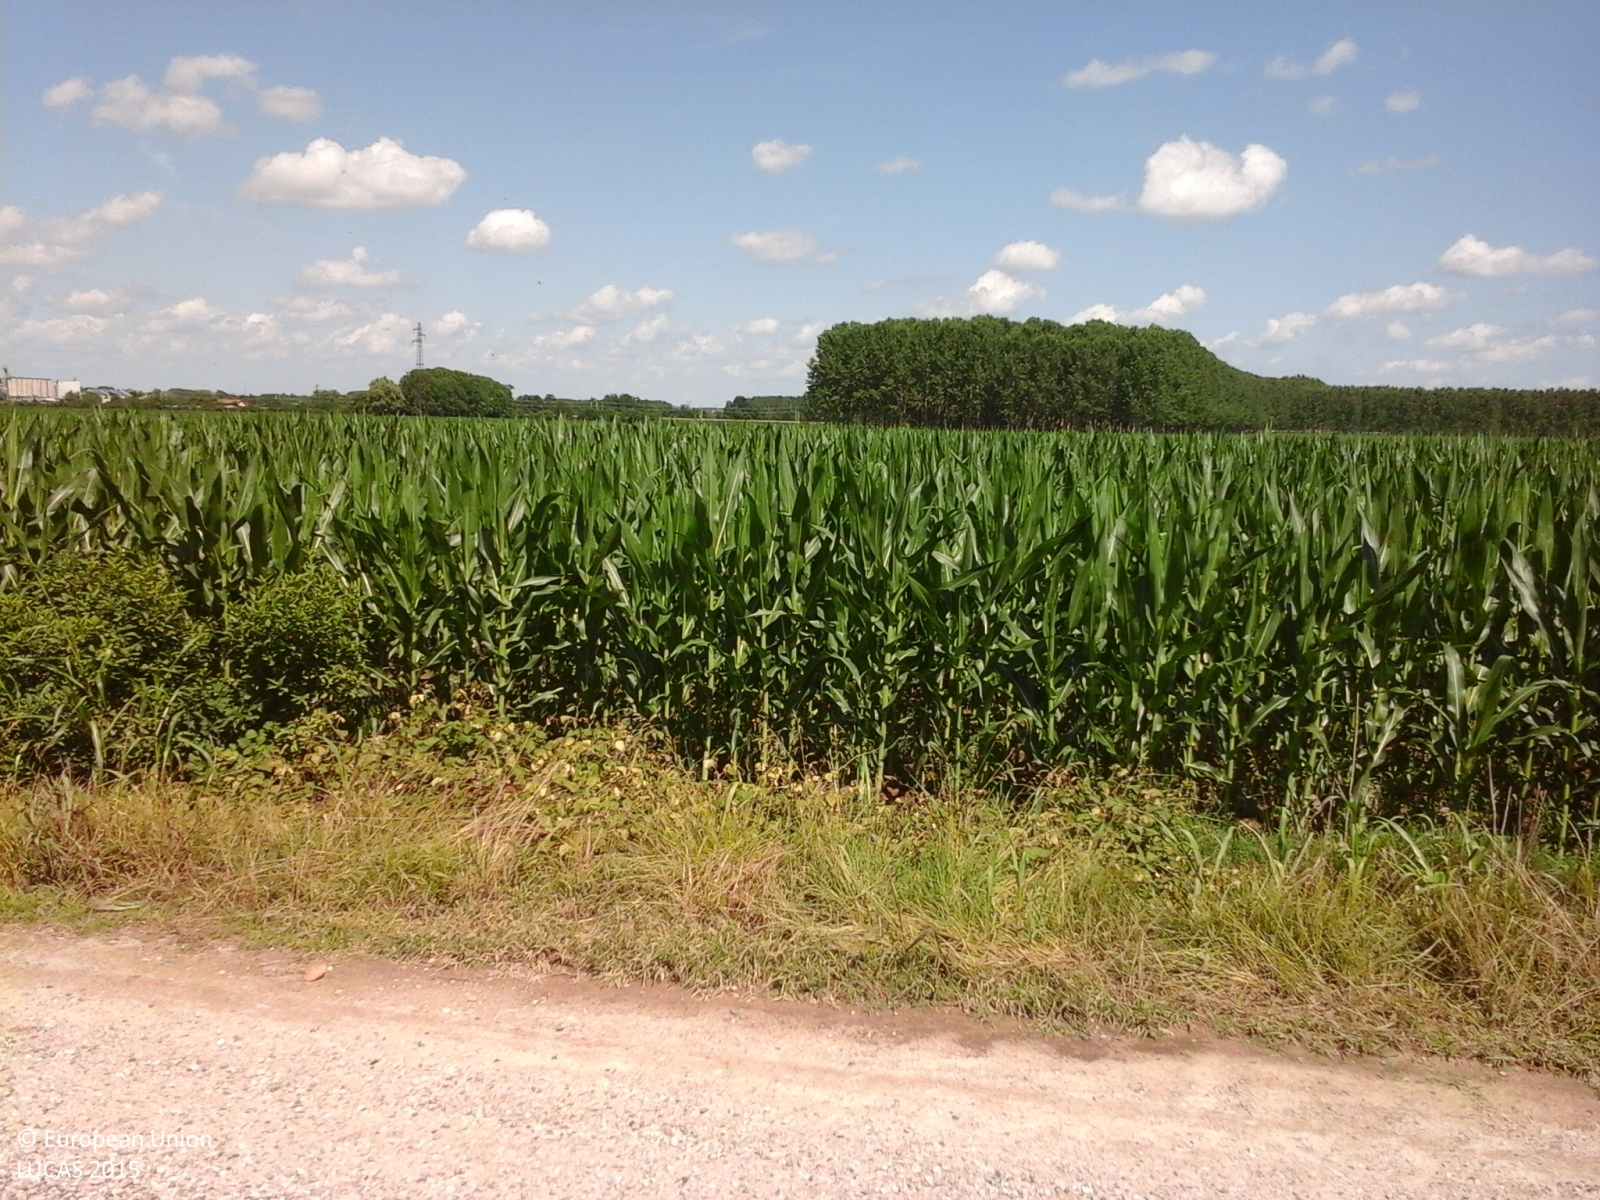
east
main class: Cropland
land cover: Maize
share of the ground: > 75 %
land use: Agriculture (excluding fallow land and kitchen gardens)
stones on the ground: 10 - 25 %
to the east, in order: Maize; Grass margins; Tracks; Grass margins; Common wheat; Maize
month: June
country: IT
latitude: 44.9572
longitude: 7.7350
